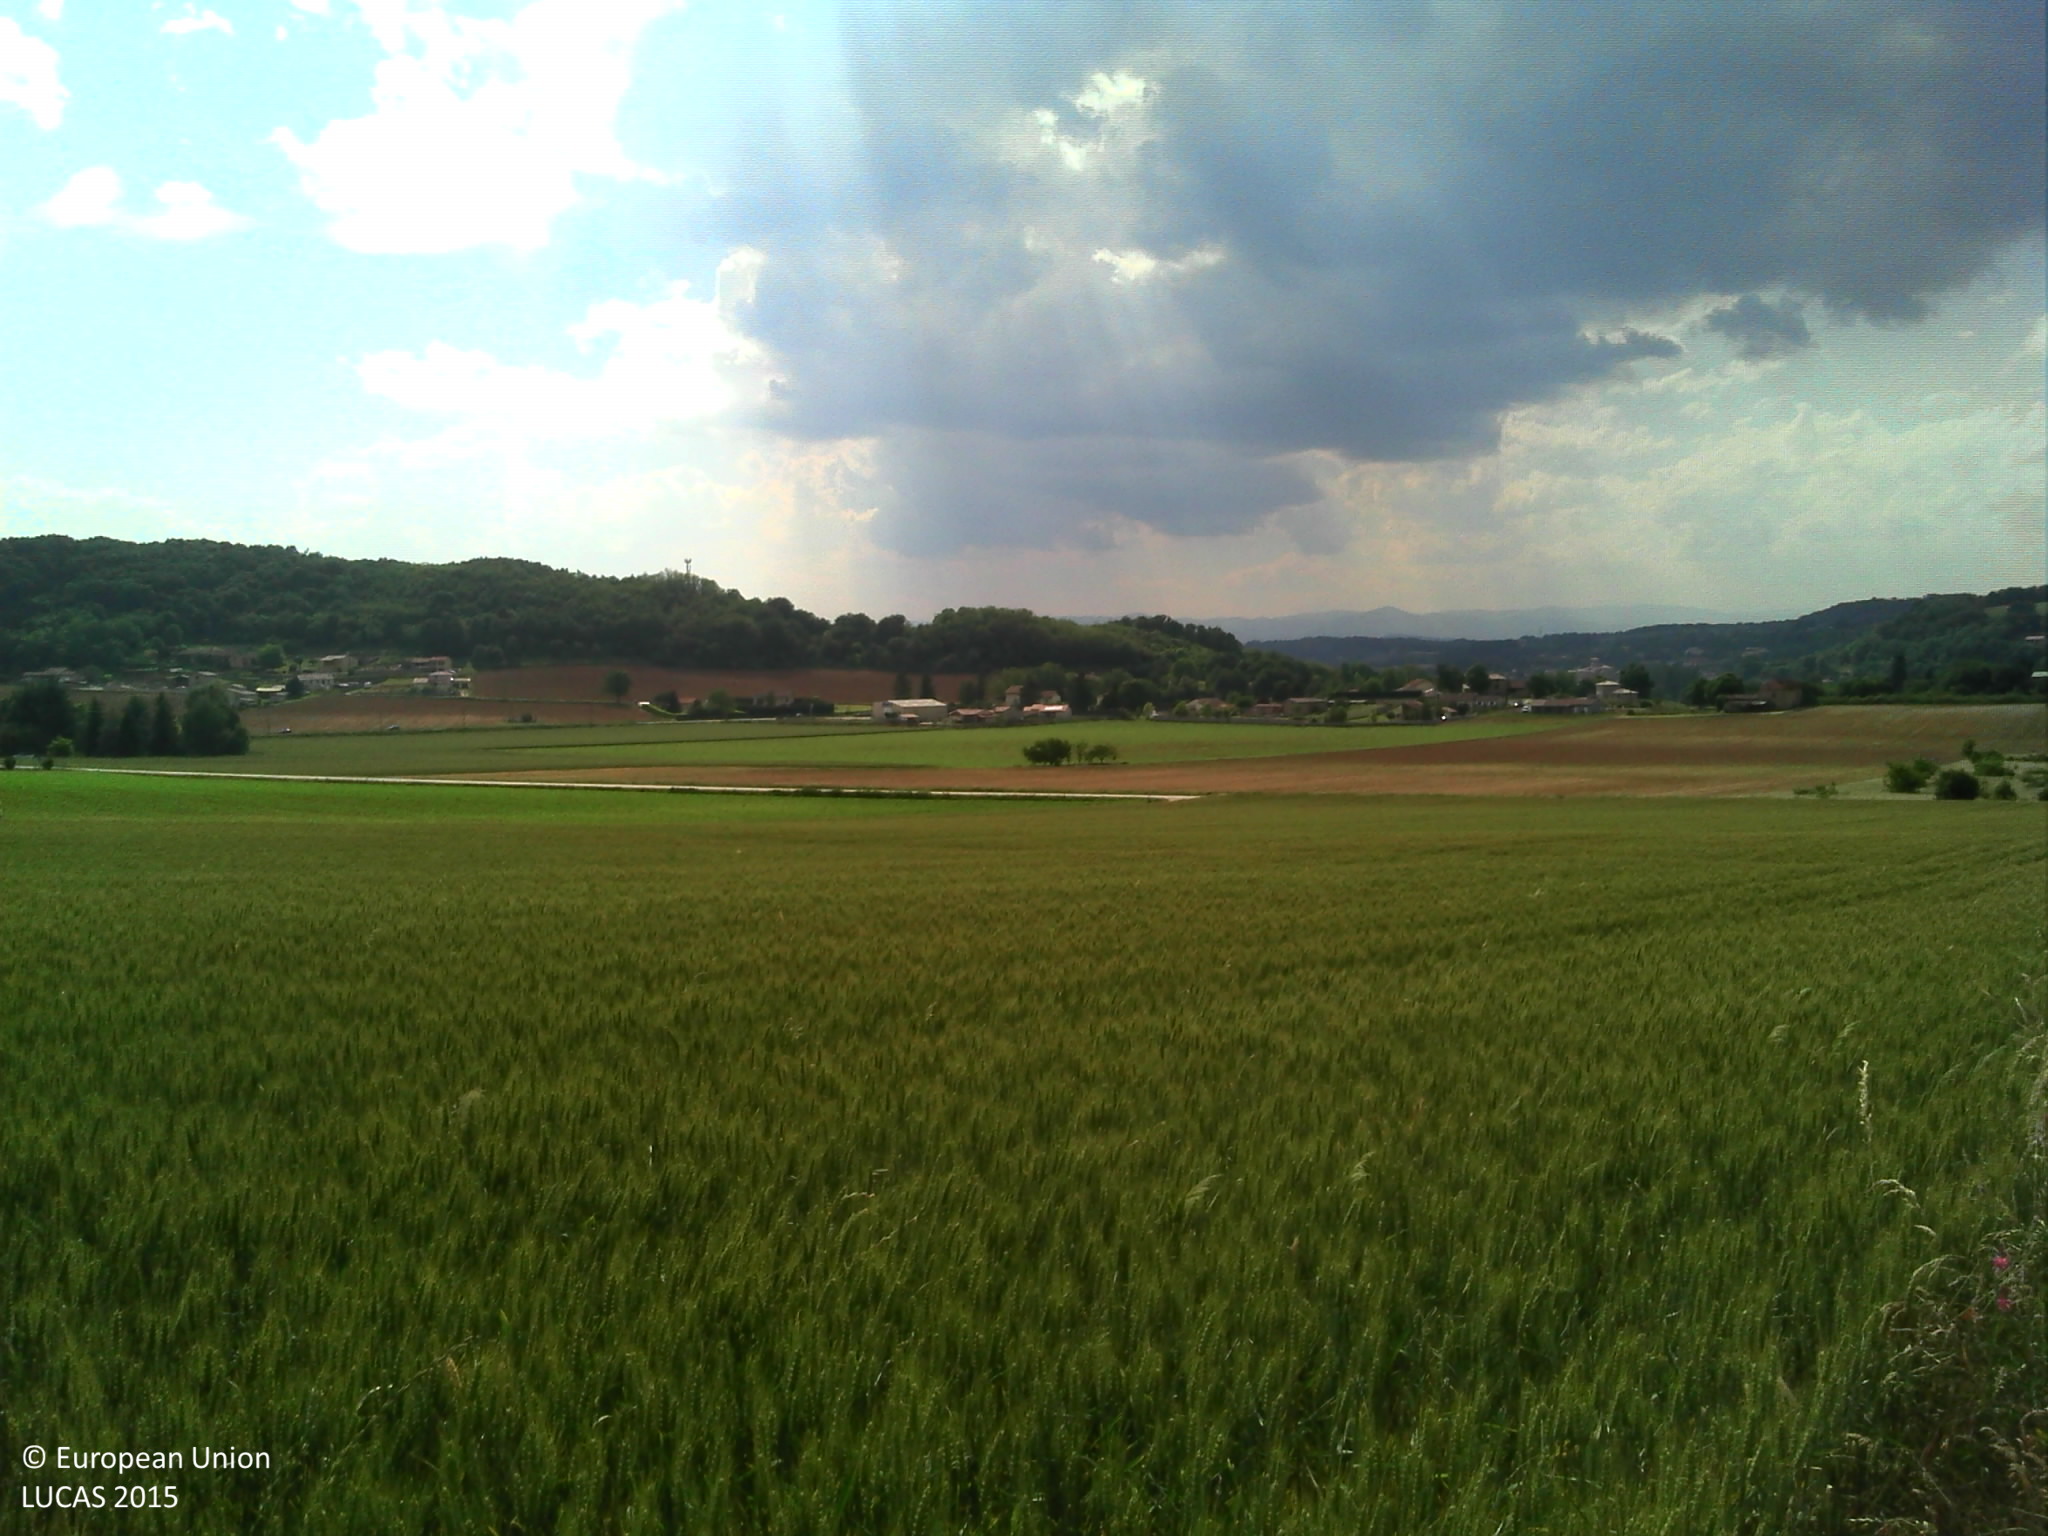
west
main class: Cropland
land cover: Durum wheat
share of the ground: > 75 %
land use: Agriculture (excluding fallow land and kitchen gardens)
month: May
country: FR
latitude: 45.1156
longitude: 5.0097
